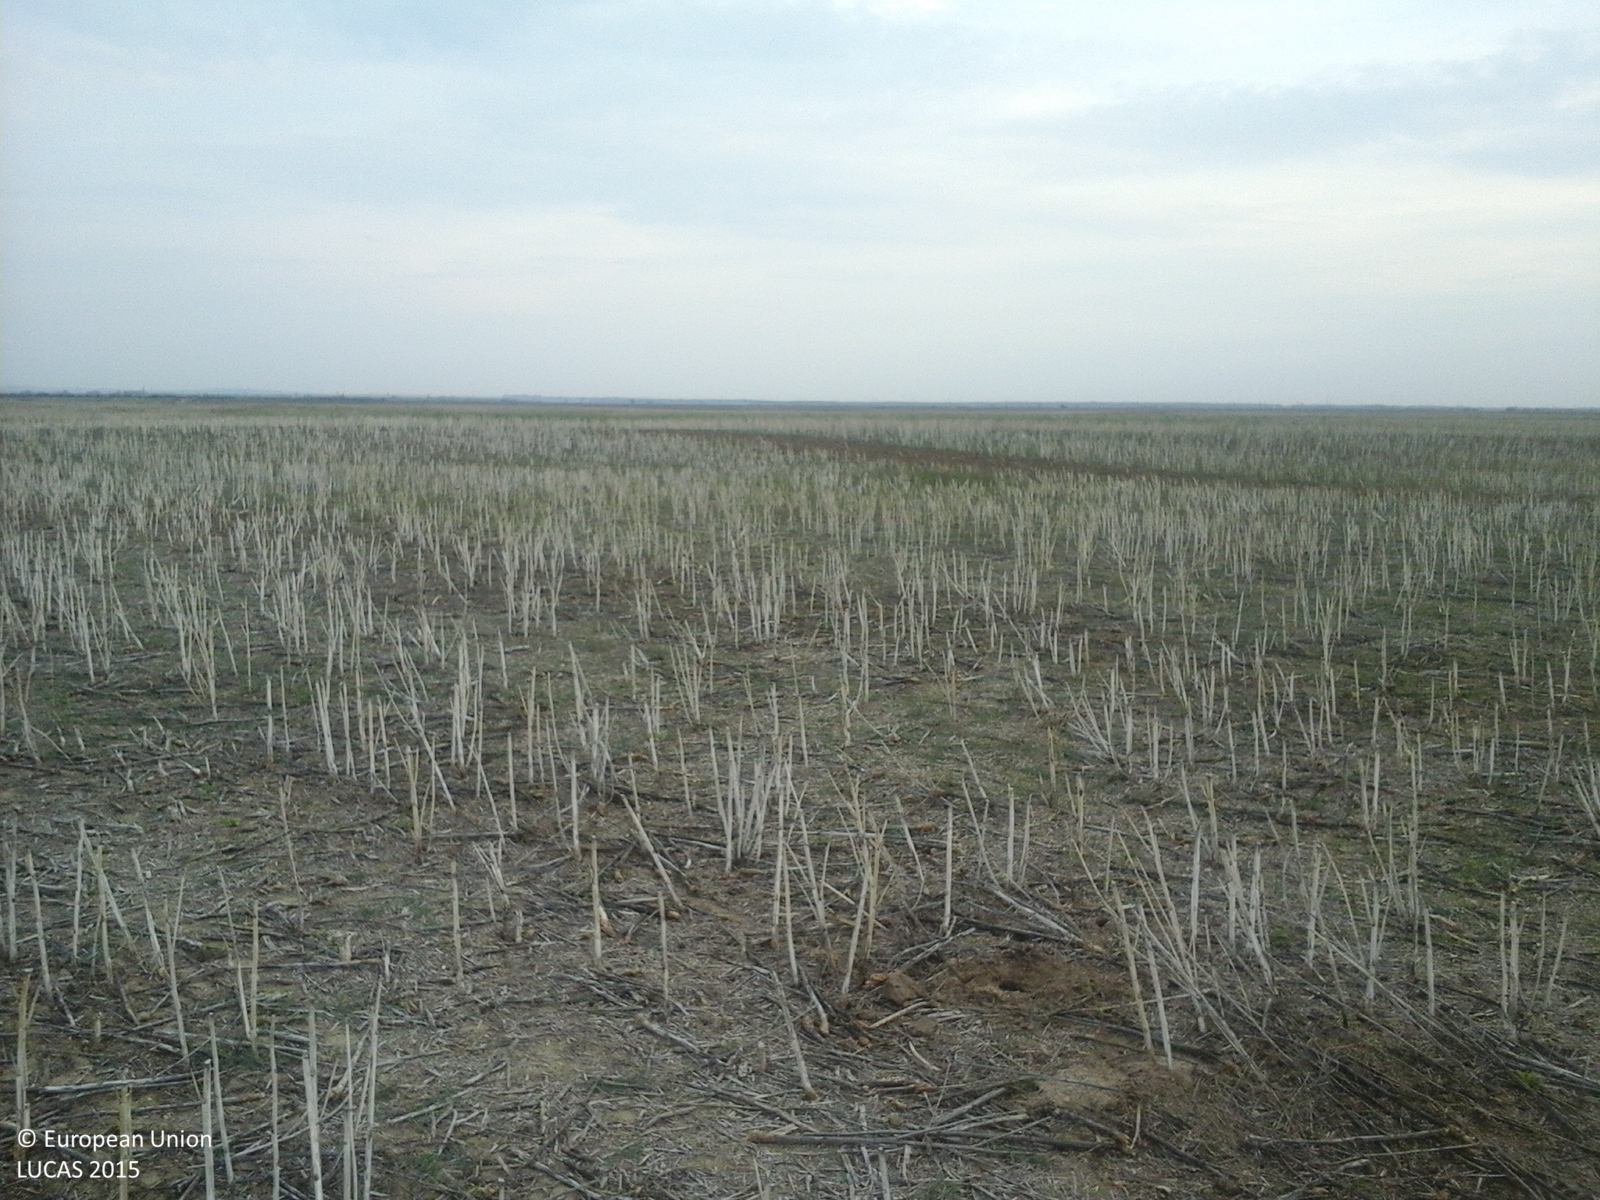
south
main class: Cropland
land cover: Rape and turnip rape
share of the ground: < 10 %
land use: Agriculture (excluding fallow land and kitchen gardens)
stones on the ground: < 10 %
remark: Harvested field
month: August
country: RO
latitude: 46.1804
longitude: 21.5272
